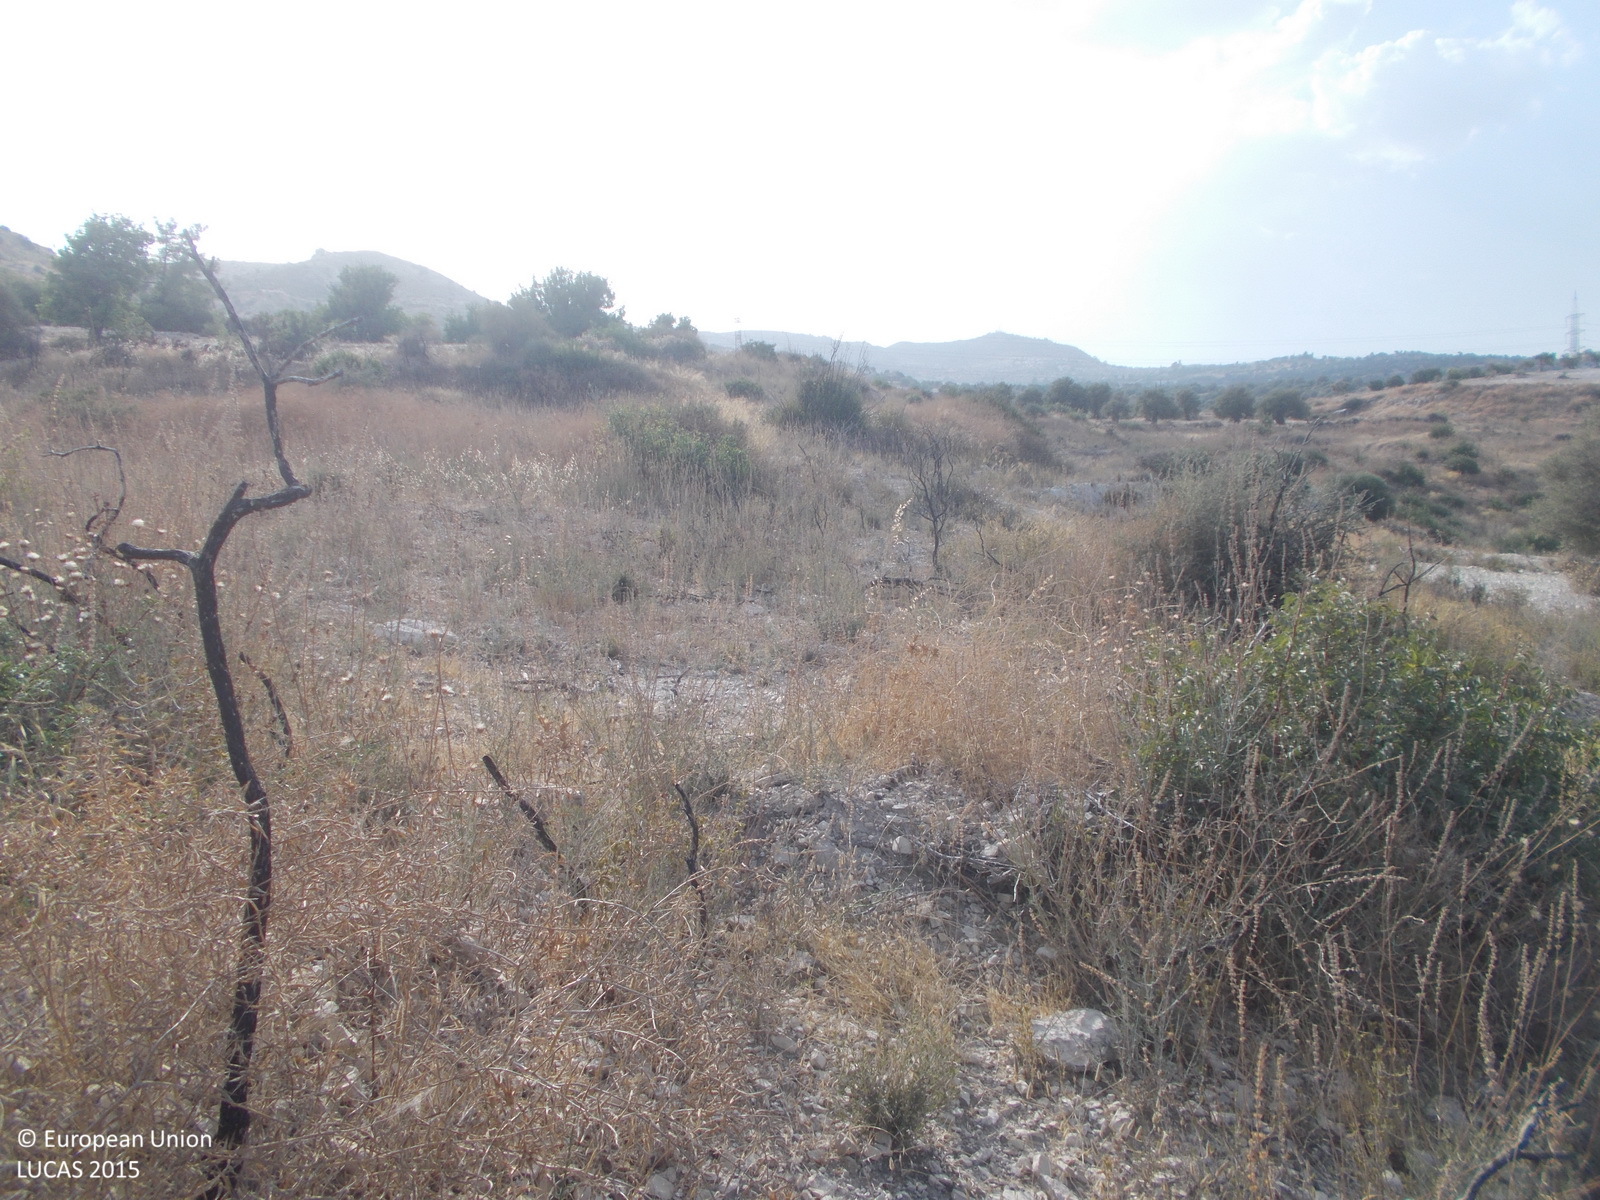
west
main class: Shrubland
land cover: Shrubland without tree cover
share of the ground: 50 - 75 %
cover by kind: shrubs 55 %, herbaceous plants 30 %, unconsolidated bare surface 15 %
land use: Semi-natural and natural areas not in use
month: April
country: CY
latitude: 34.8571
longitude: 33.3377
